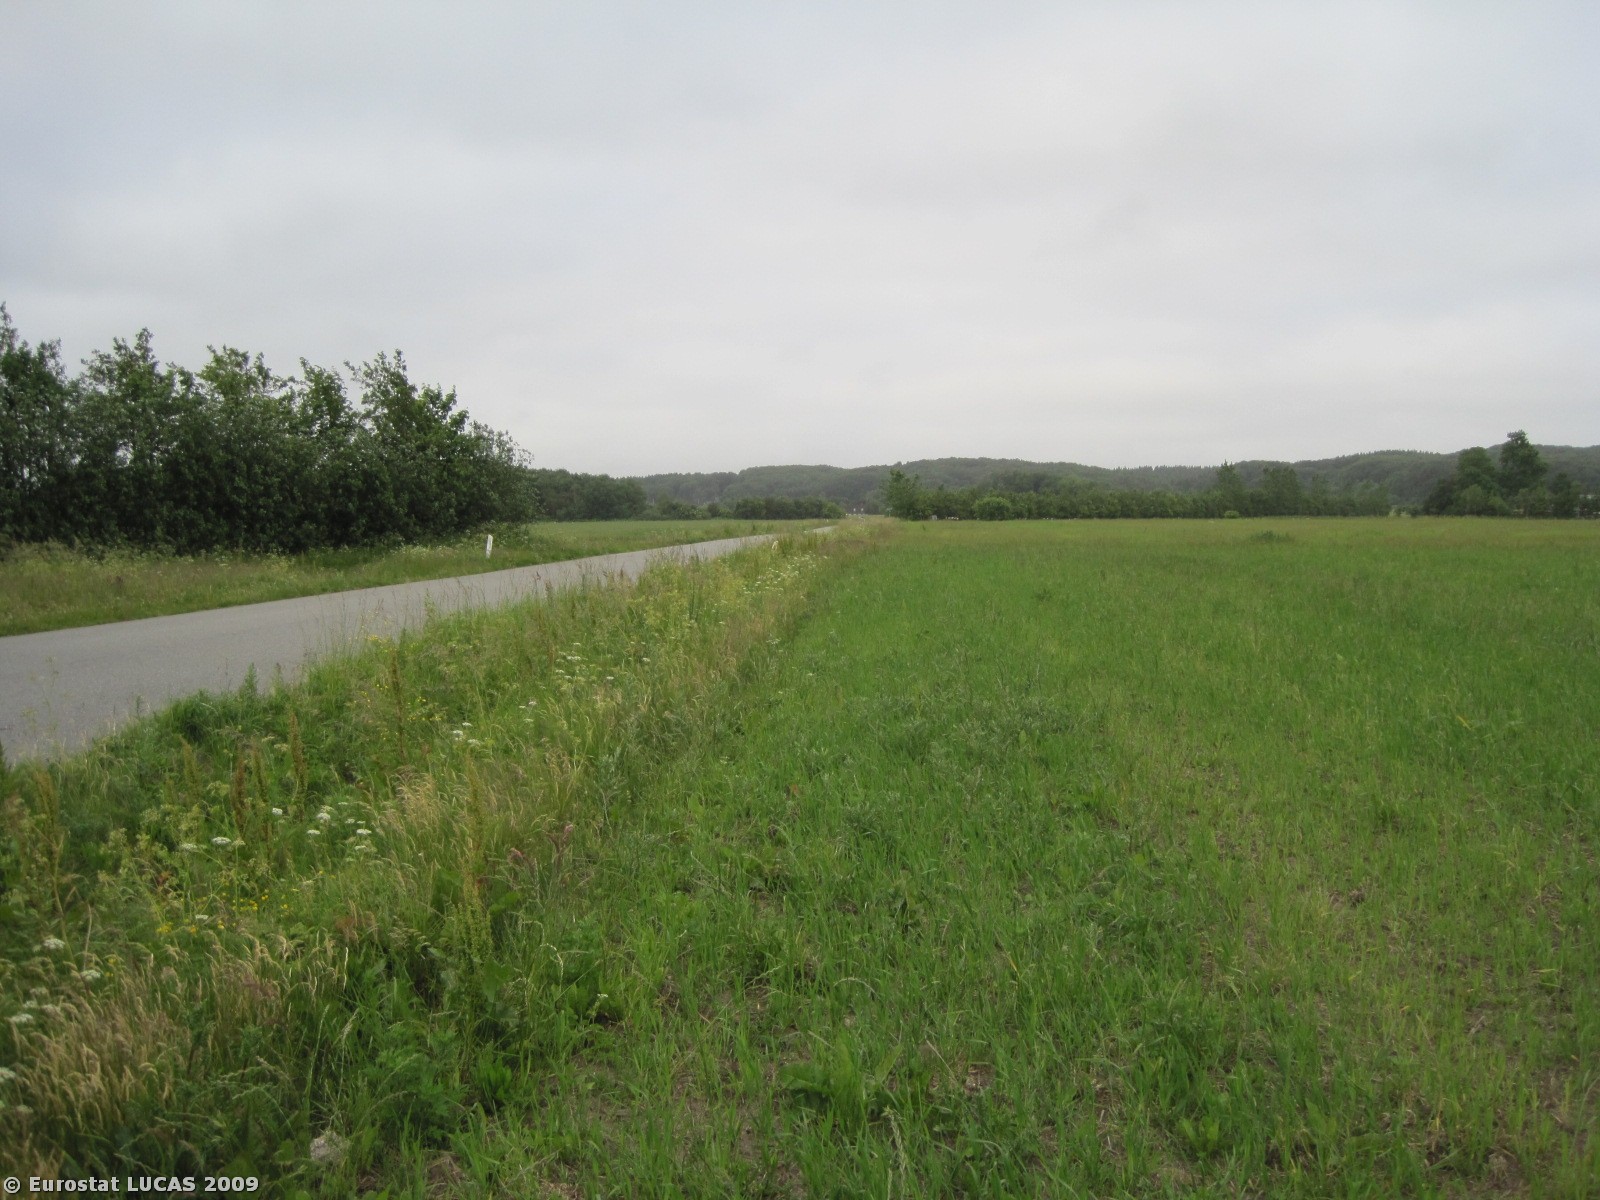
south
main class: Cropland
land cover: Rye
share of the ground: 50 - 75 %
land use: Agriculture (excluding fallow land and kitchen gardens)
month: June
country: DK
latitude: 57.1585
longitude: 10.0495
